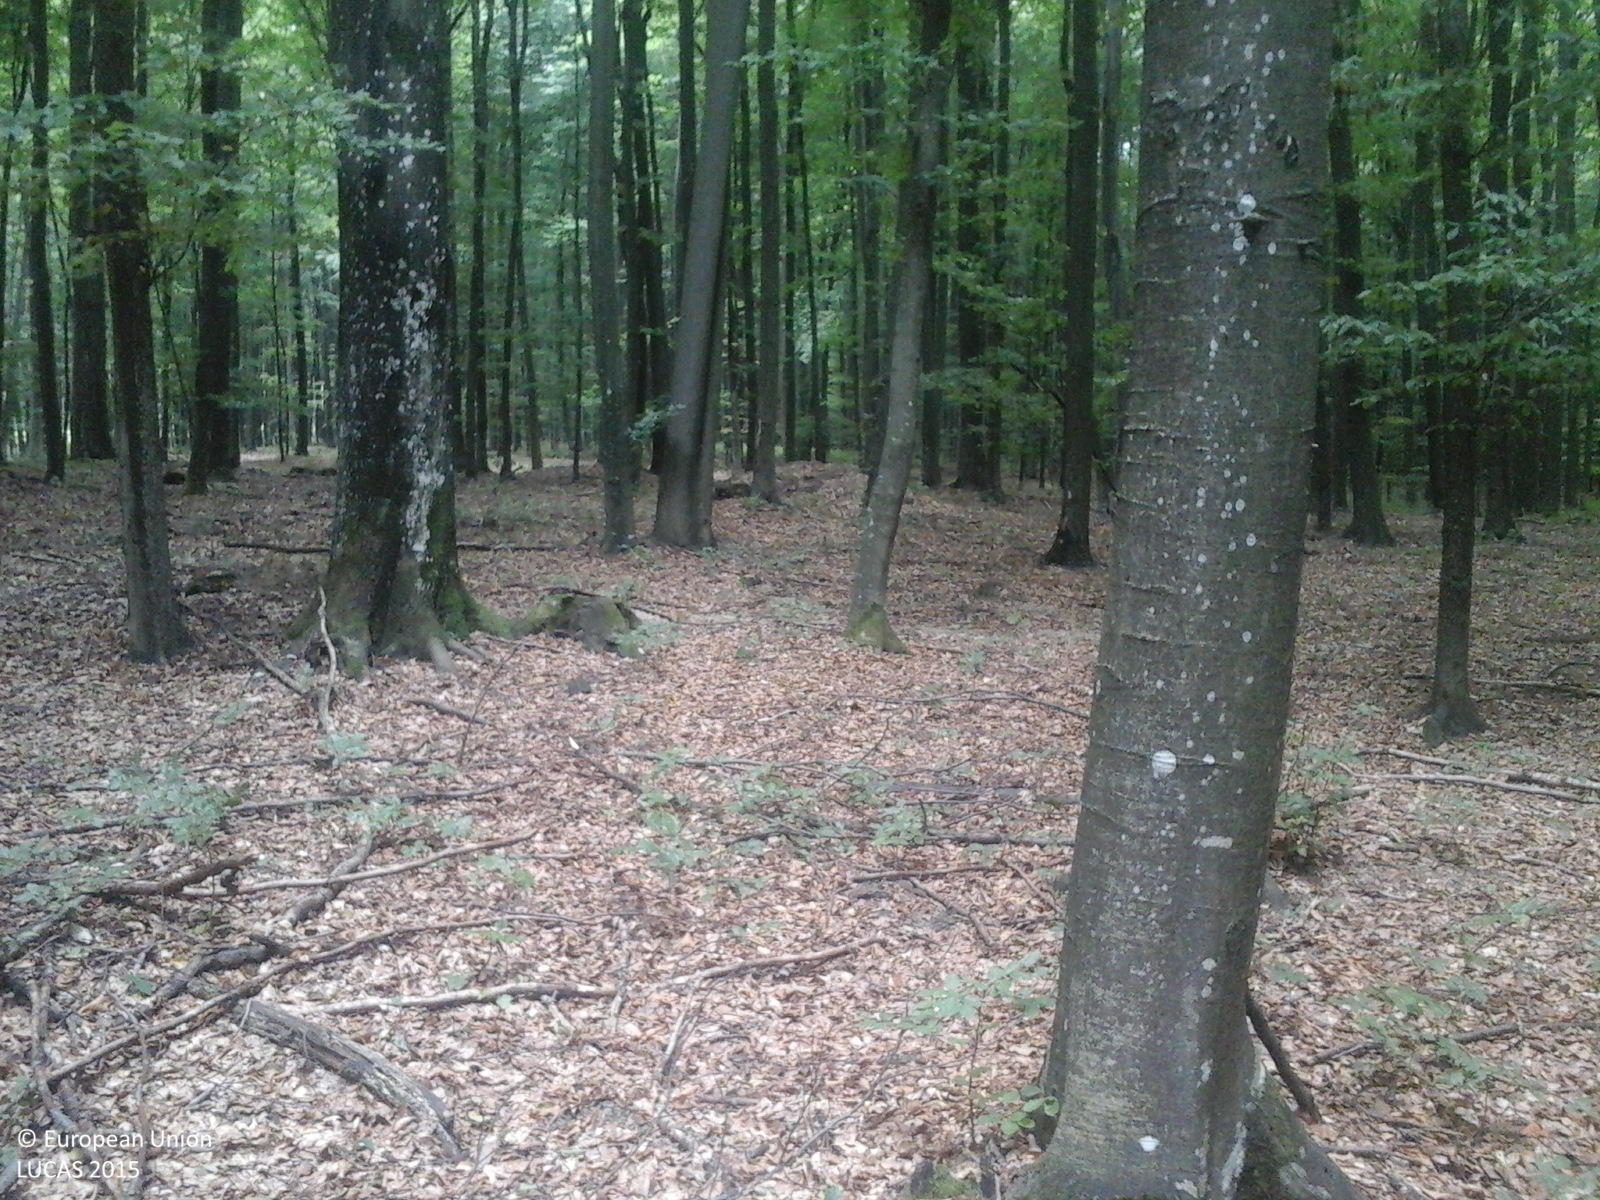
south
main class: Woodland
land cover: Broadleaved woodland
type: mesophytic deciduous forest
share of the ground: > 75 %
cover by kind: broadleaved forest trees 100 %
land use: Forestry
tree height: > 5 m
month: September
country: RO
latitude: 47.9851
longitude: 23.5431
